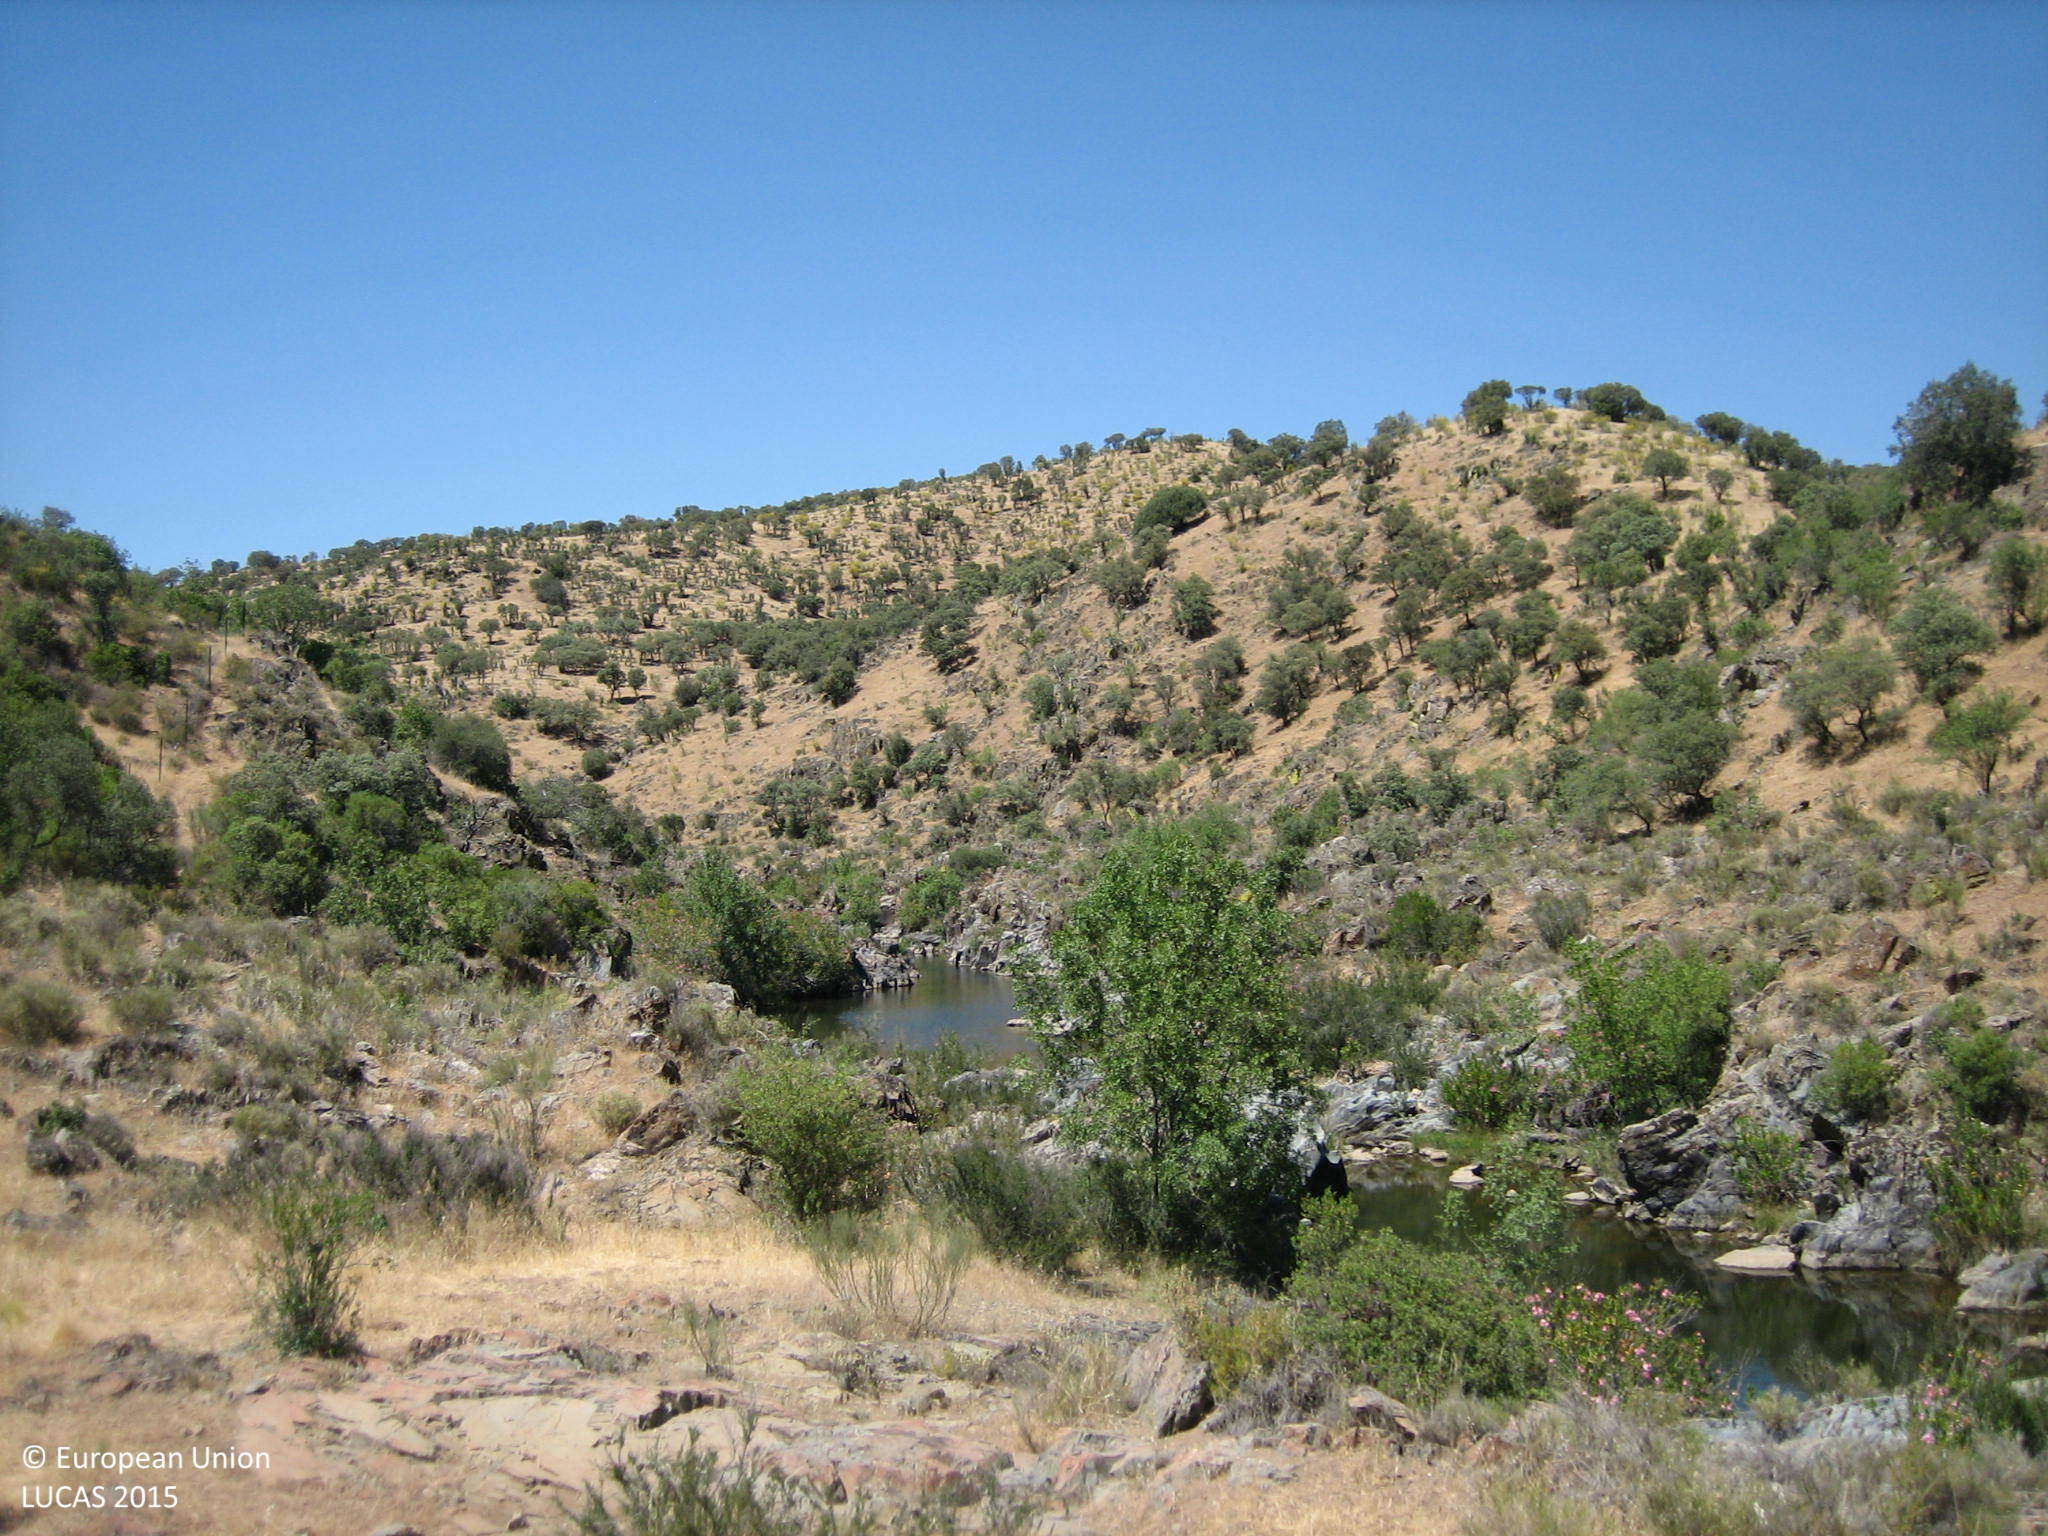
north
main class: Woodland
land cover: Broadleaved woodland
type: broadleaved evergreen forest
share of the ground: > 75 %
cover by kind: shrubs 80 %, broadleaved forest trees 20 %
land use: Forestry
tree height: < 5 m
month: May
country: ES
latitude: 38.4569
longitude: -3.9593
